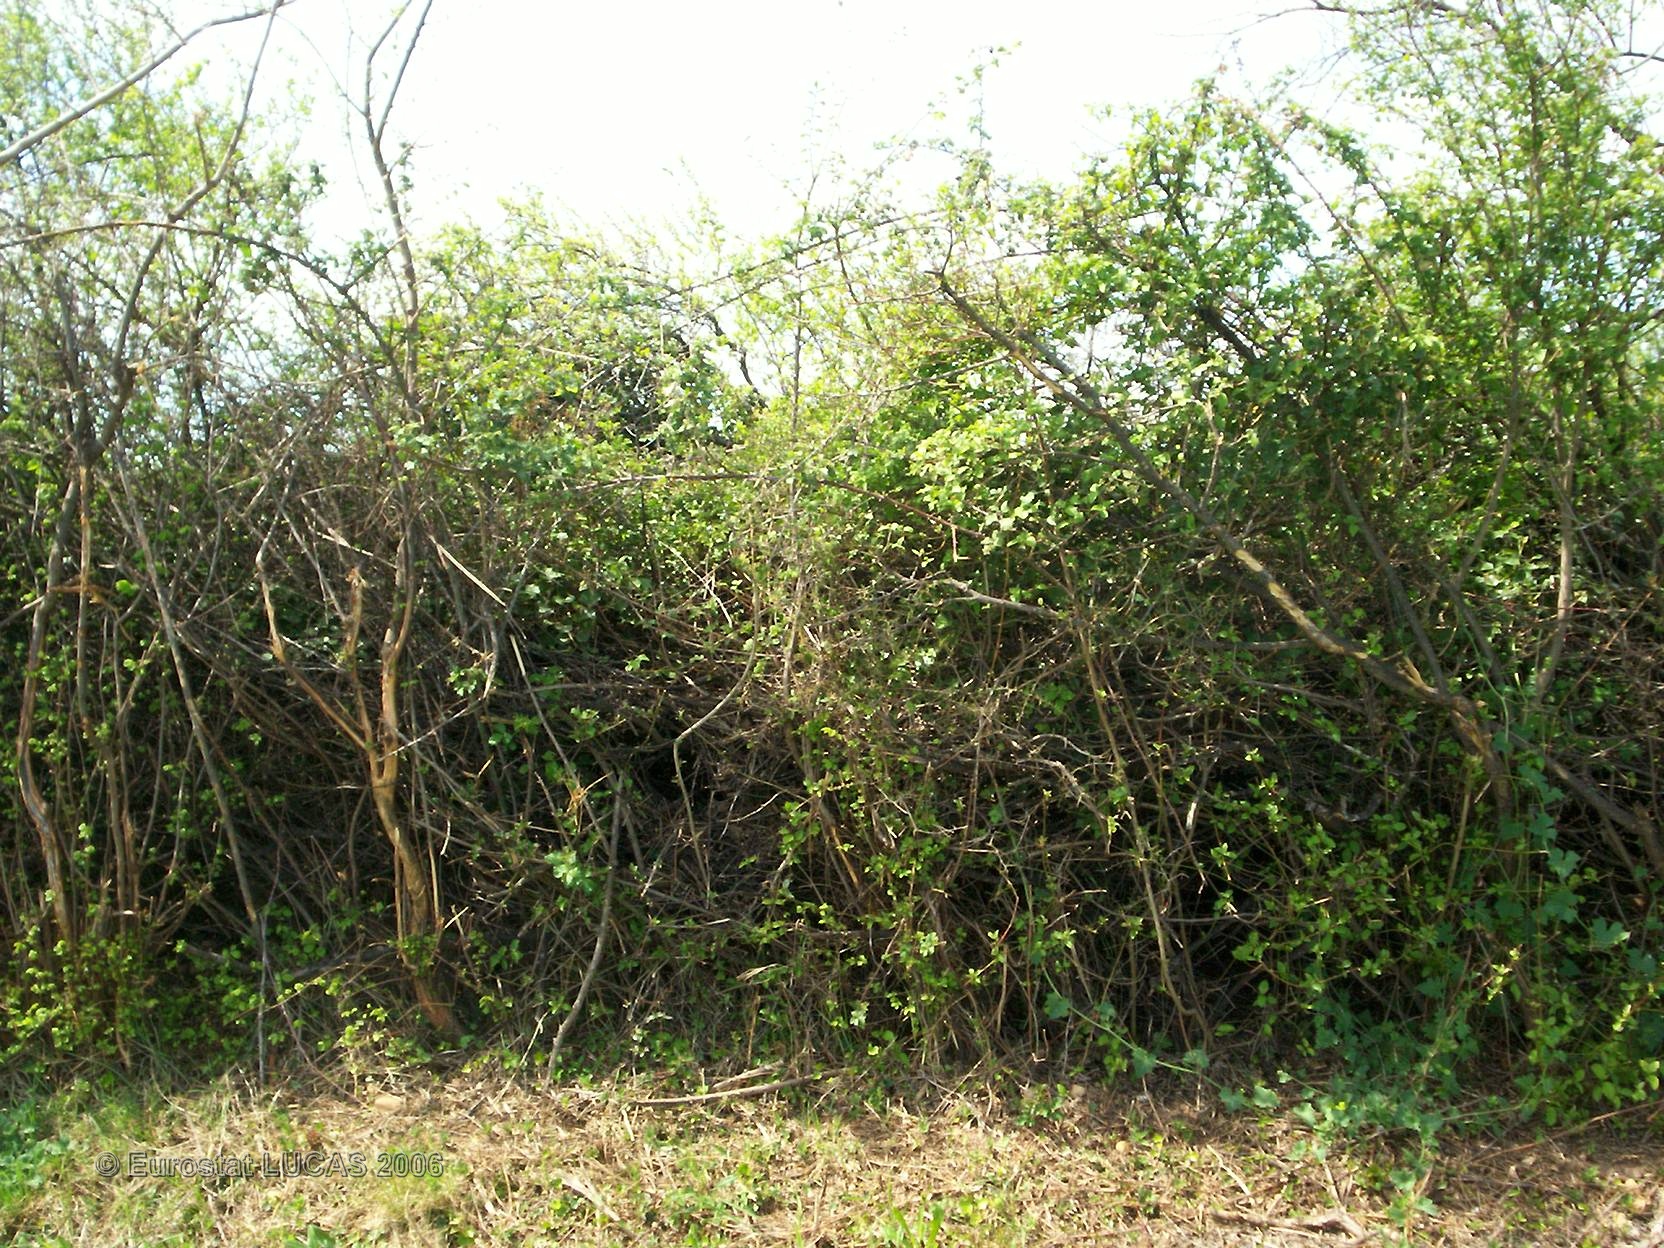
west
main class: Grassland
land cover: Grassland without tree/shrub cover
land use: Agriculture (excluding fallow land and kitchen gardens)
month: April
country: FR
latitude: 43.6835
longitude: 4.9109
